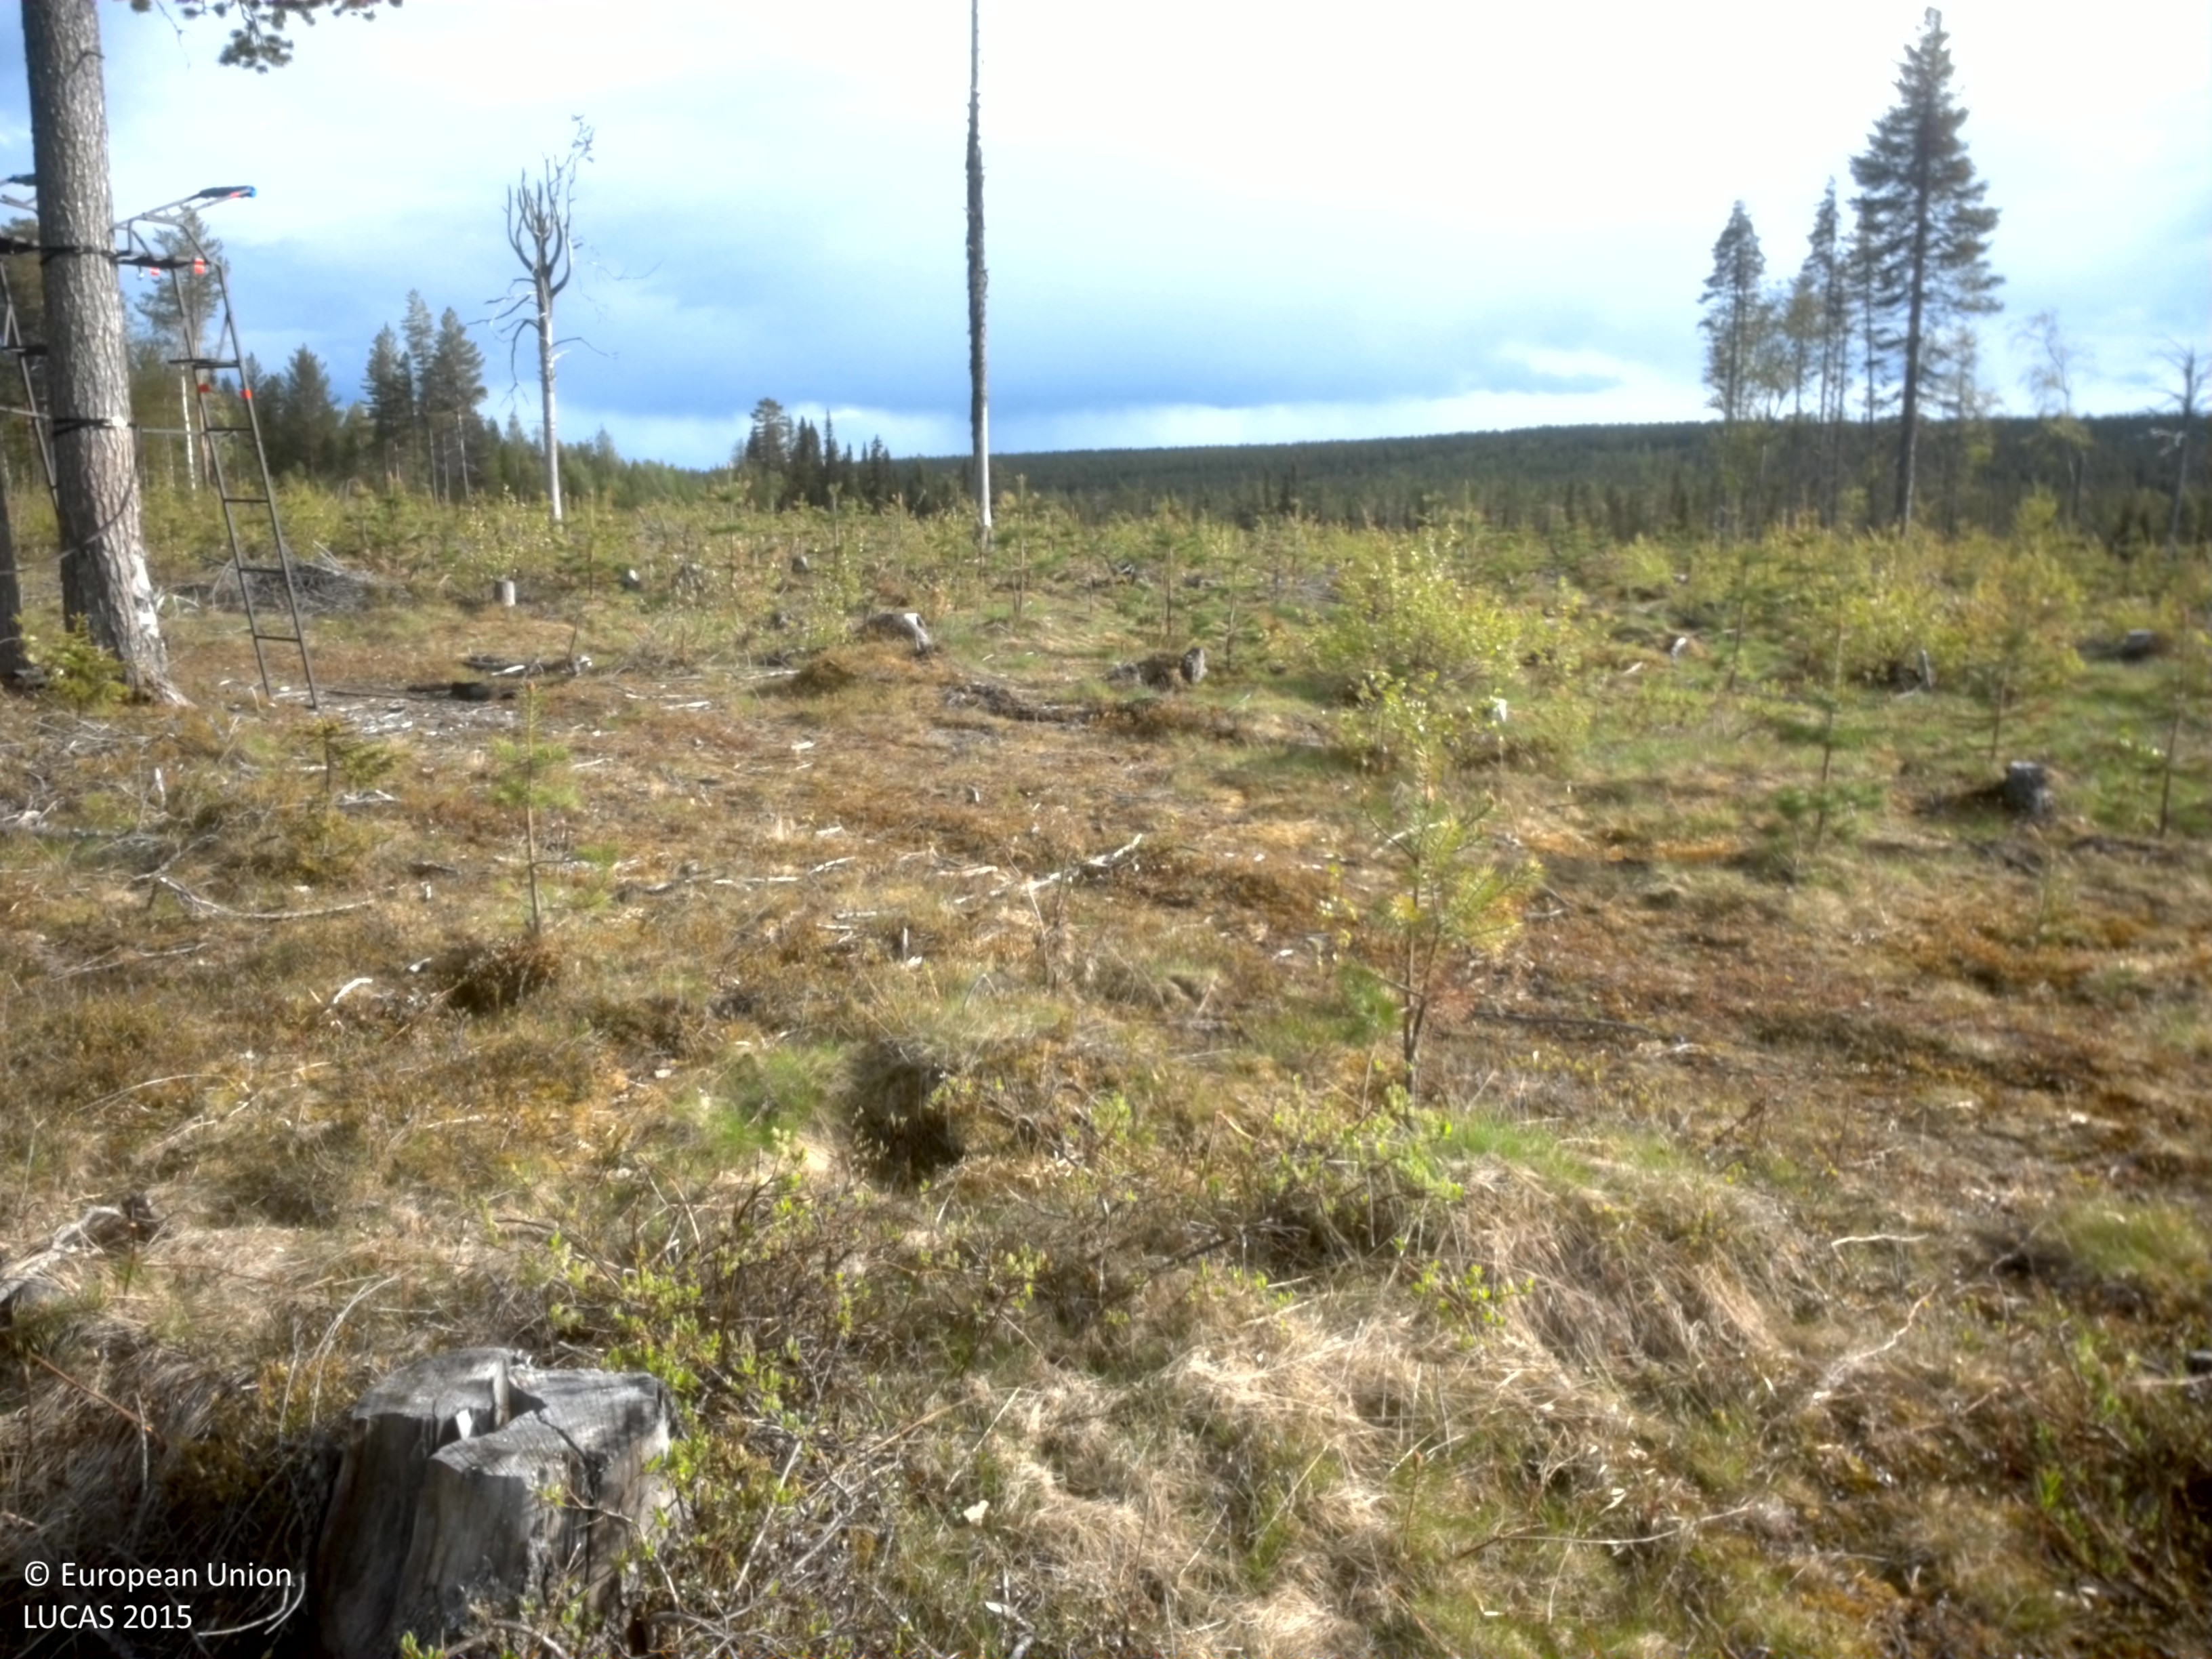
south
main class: Shrubland
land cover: Shrubland with sparse tree cover
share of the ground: 10 - 25 %
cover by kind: herbaceous plants 60 %, lichens and mosses 20 %, shrubs 15 %, broadleaved forest trees 5 %
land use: Forestry
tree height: < 5 m
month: June
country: SE
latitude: 66.8683
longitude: 22.3518
